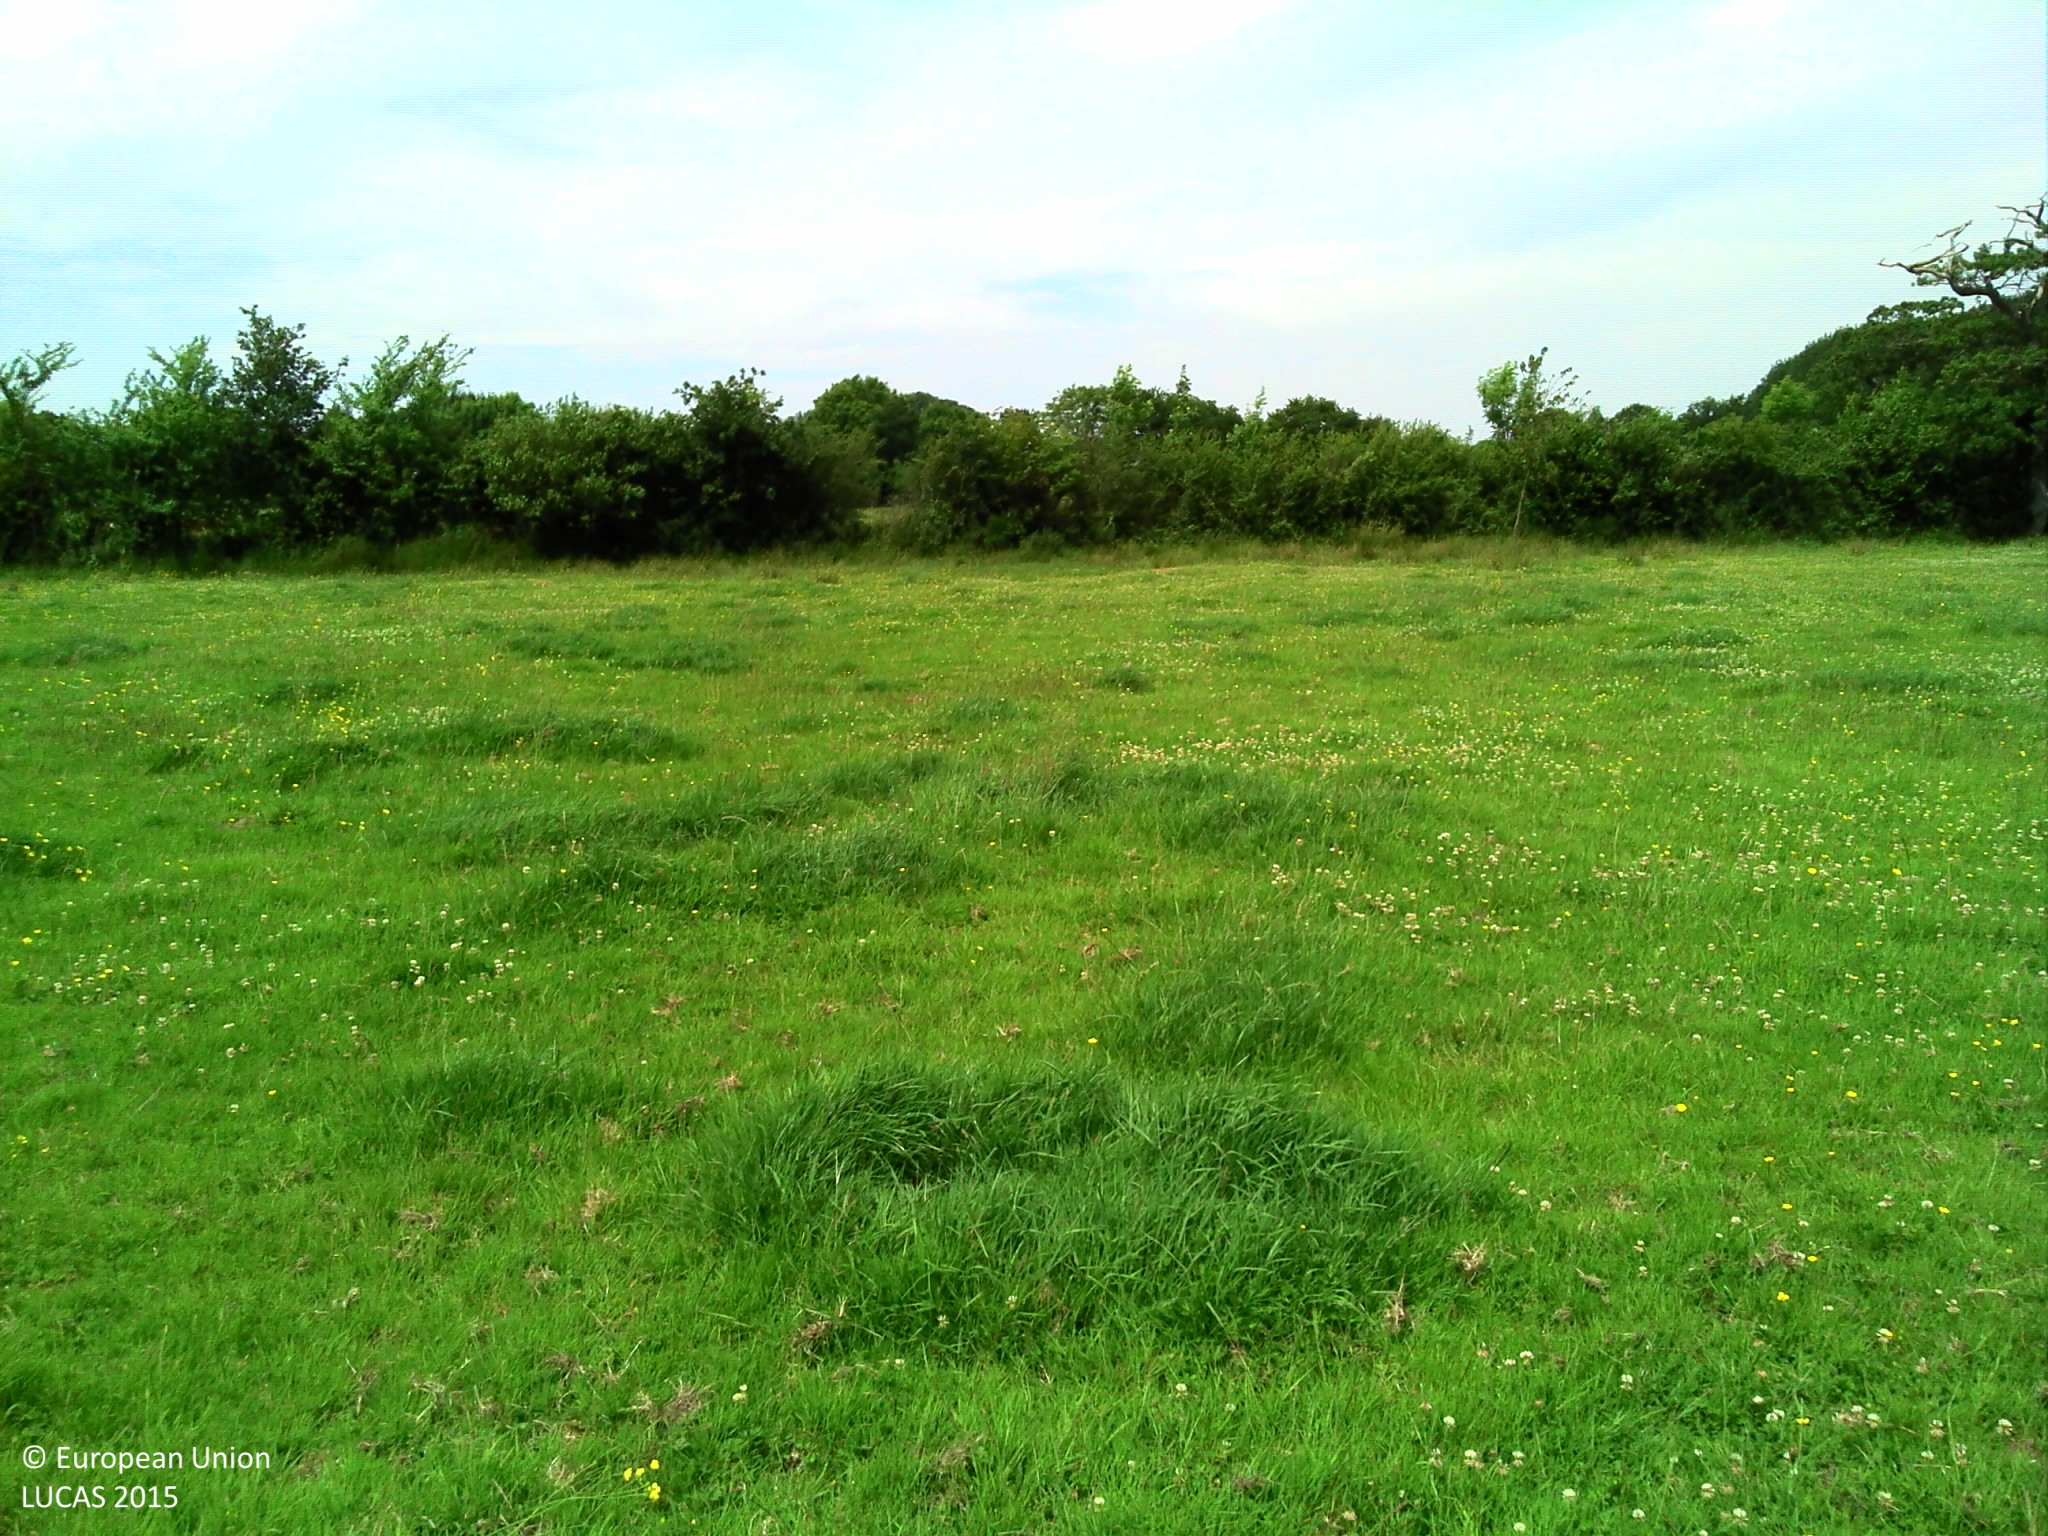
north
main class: Grassland
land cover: Grassland without tree/shrub cover
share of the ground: > 75 %
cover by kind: herbaceous plants 100 %
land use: Agriculture (excluding fallow land and kitchen gardens)
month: June
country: FR
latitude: 49.1697
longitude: -1.4457
